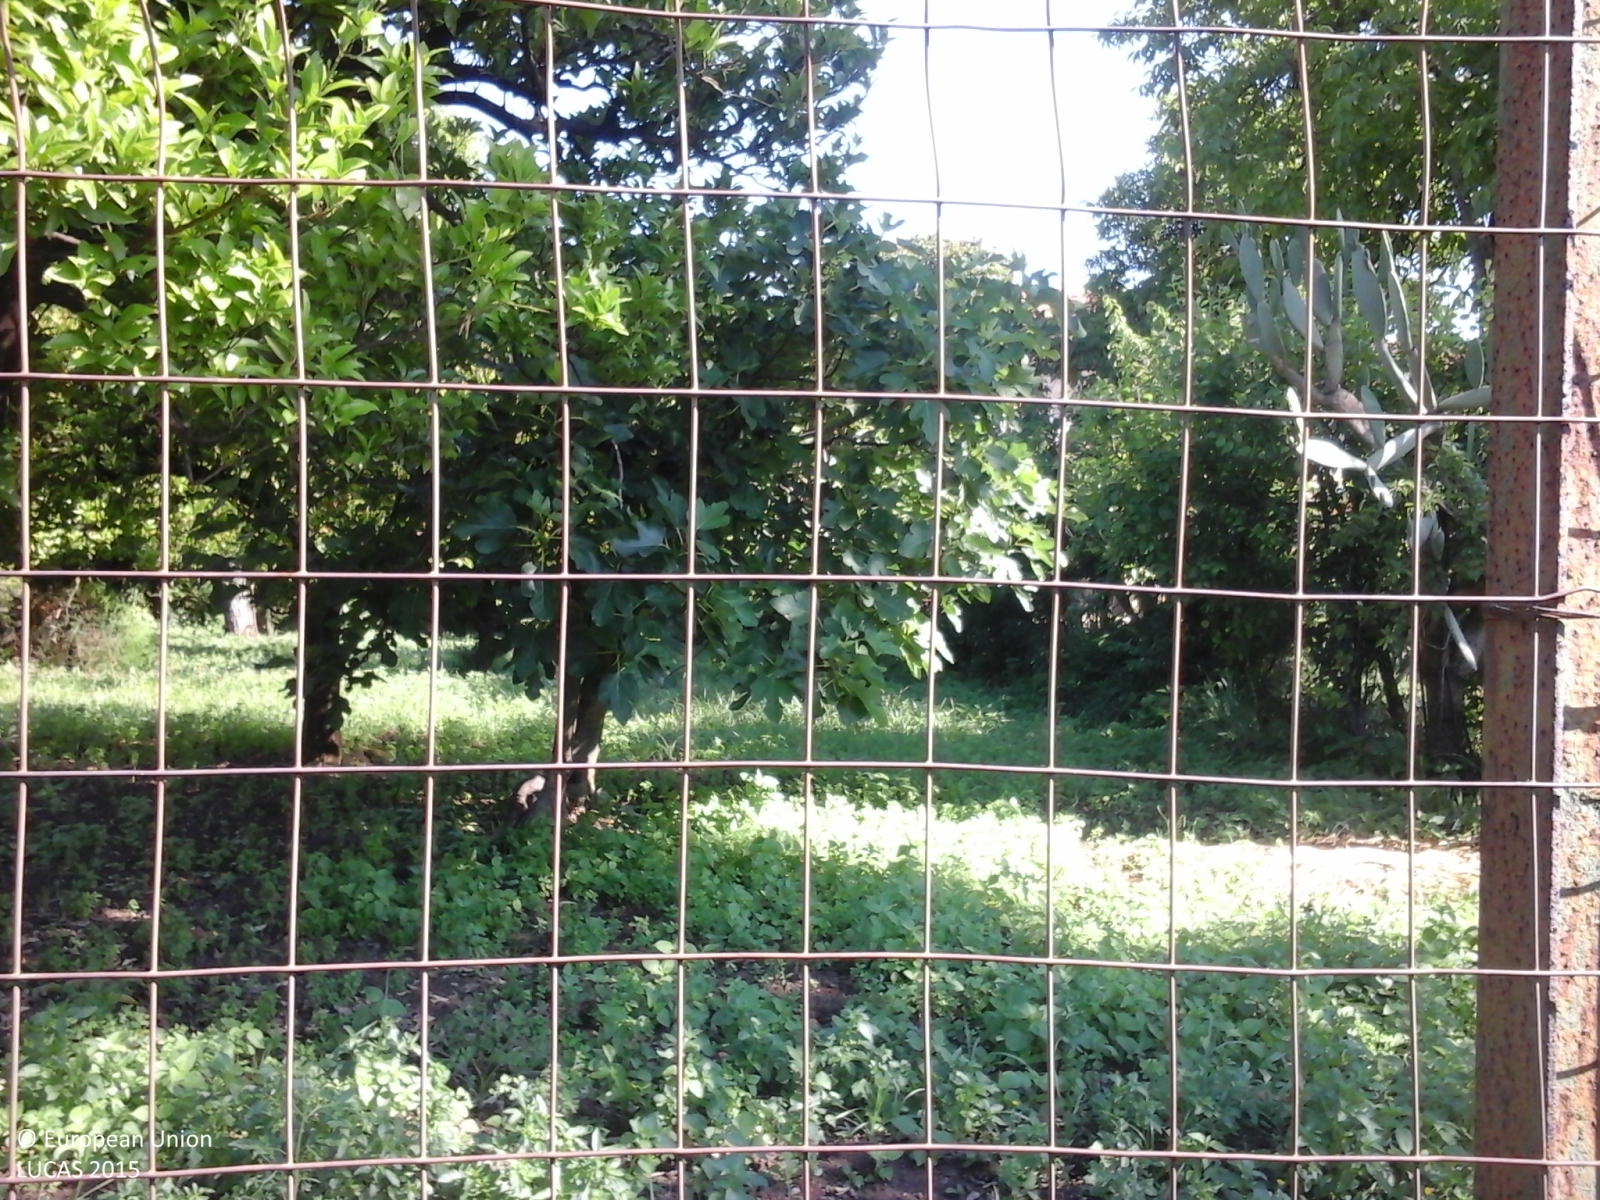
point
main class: Cropland
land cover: Oranges
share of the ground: > 75 %
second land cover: Spontaneously vegetated surfaces
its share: > 75 %
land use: Kitchen garden
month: June
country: IT
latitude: 40.6243
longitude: 15.0978
